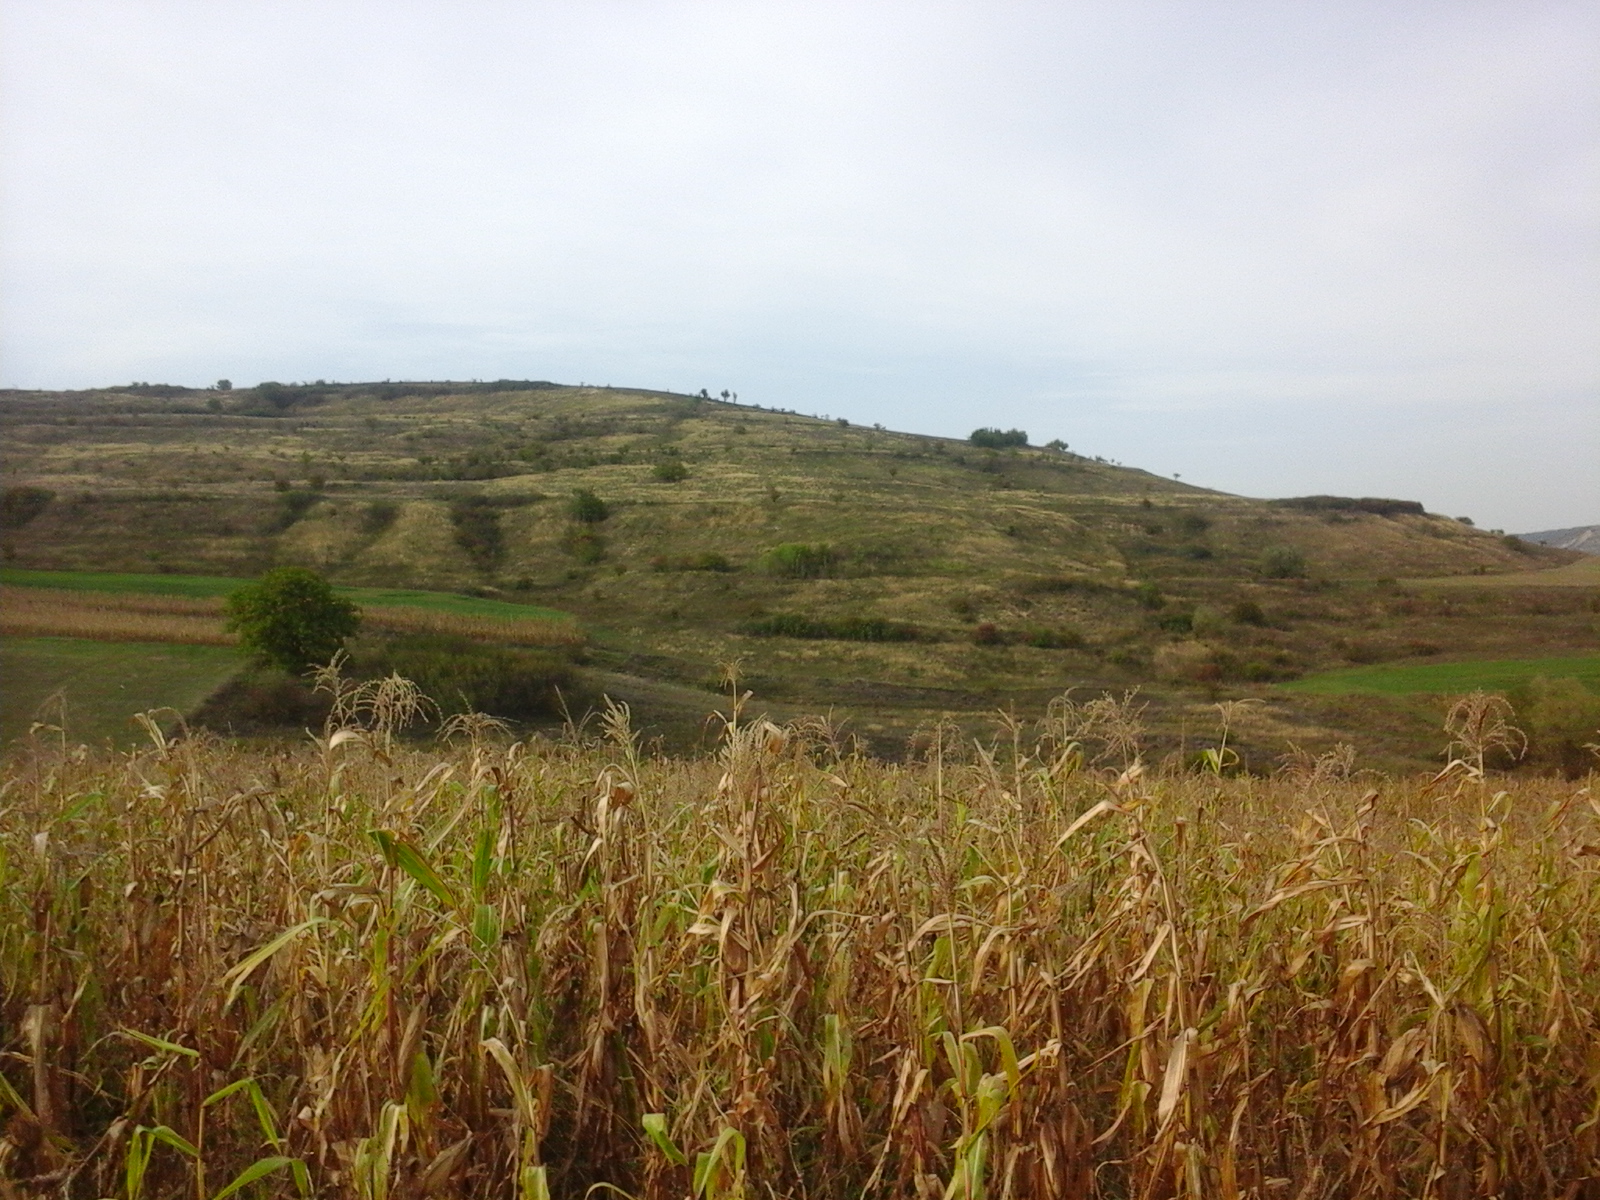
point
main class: Cropland
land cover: Maize
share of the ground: > 75 %
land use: Agriculture (excluding fallow land and kitchen gardens)
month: September
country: RO
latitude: 46.9712
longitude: 24.1872
